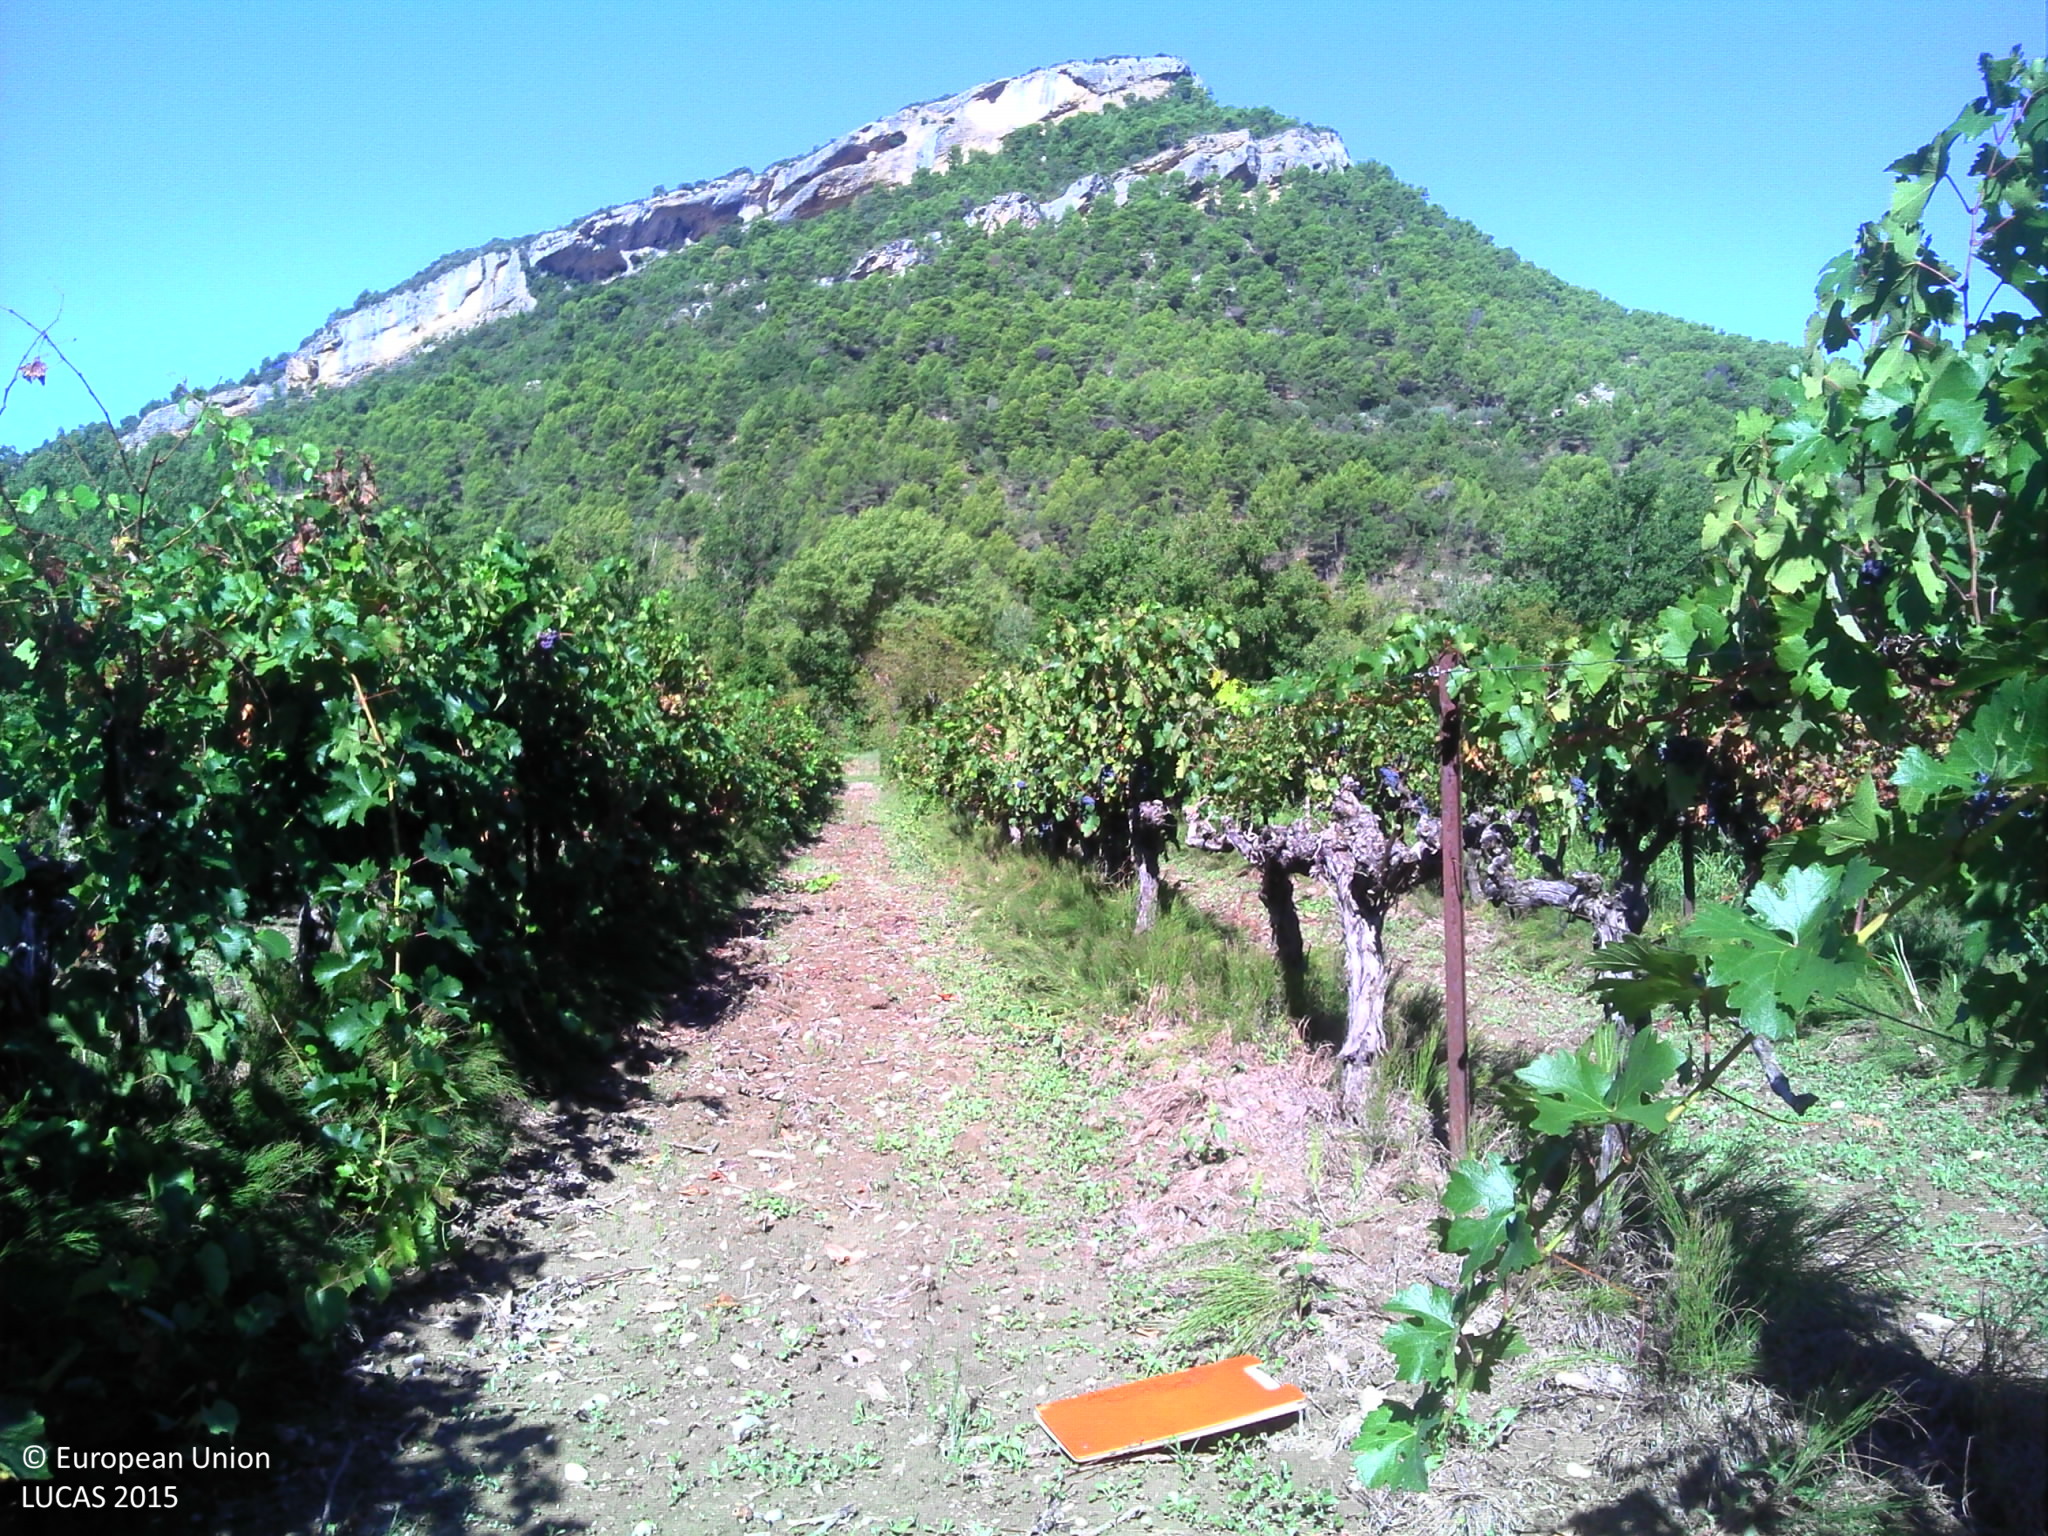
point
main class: Cropland
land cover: Vineyards
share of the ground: 50 - 75 %
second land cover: Spontaneously vegetated surfaces
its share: 10 - 25 %
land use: Agriculture (excluding fallow land and kitchen gardens)
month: September
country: FR
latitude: 44.2401
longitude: 5.2120
